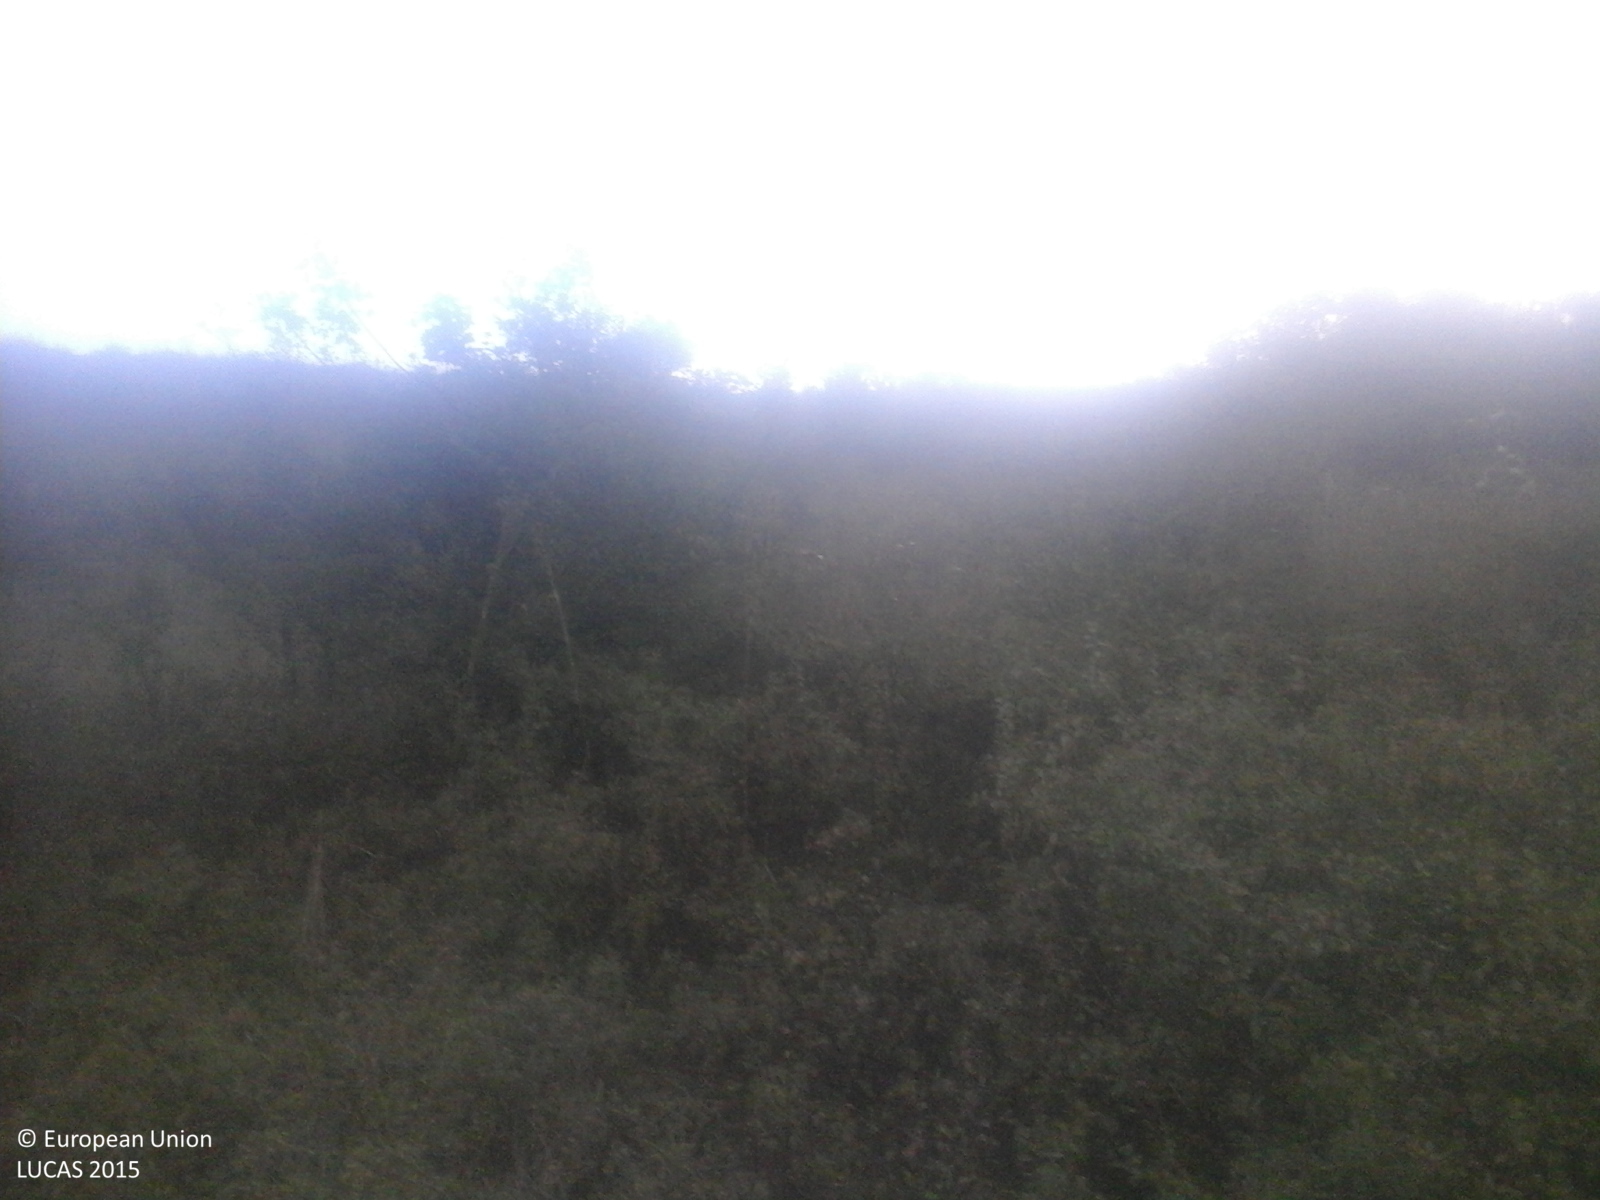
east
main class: Shrubland
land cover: Shrubland without tree cover
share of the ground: > 75 %
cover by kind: shrubs 100 %
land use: Semi-natural and natural areas not in use
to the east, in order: Shrubland without tree cover; Grassland with sparse tree/shrub cover; Abandoned hedges; Grassland without tree/shrub cover; Tracks; Spontaneously vegetated surfaces; Grassland without tree/shrub cover
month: September
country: RO
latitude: 44.6723
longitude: 23.3348
